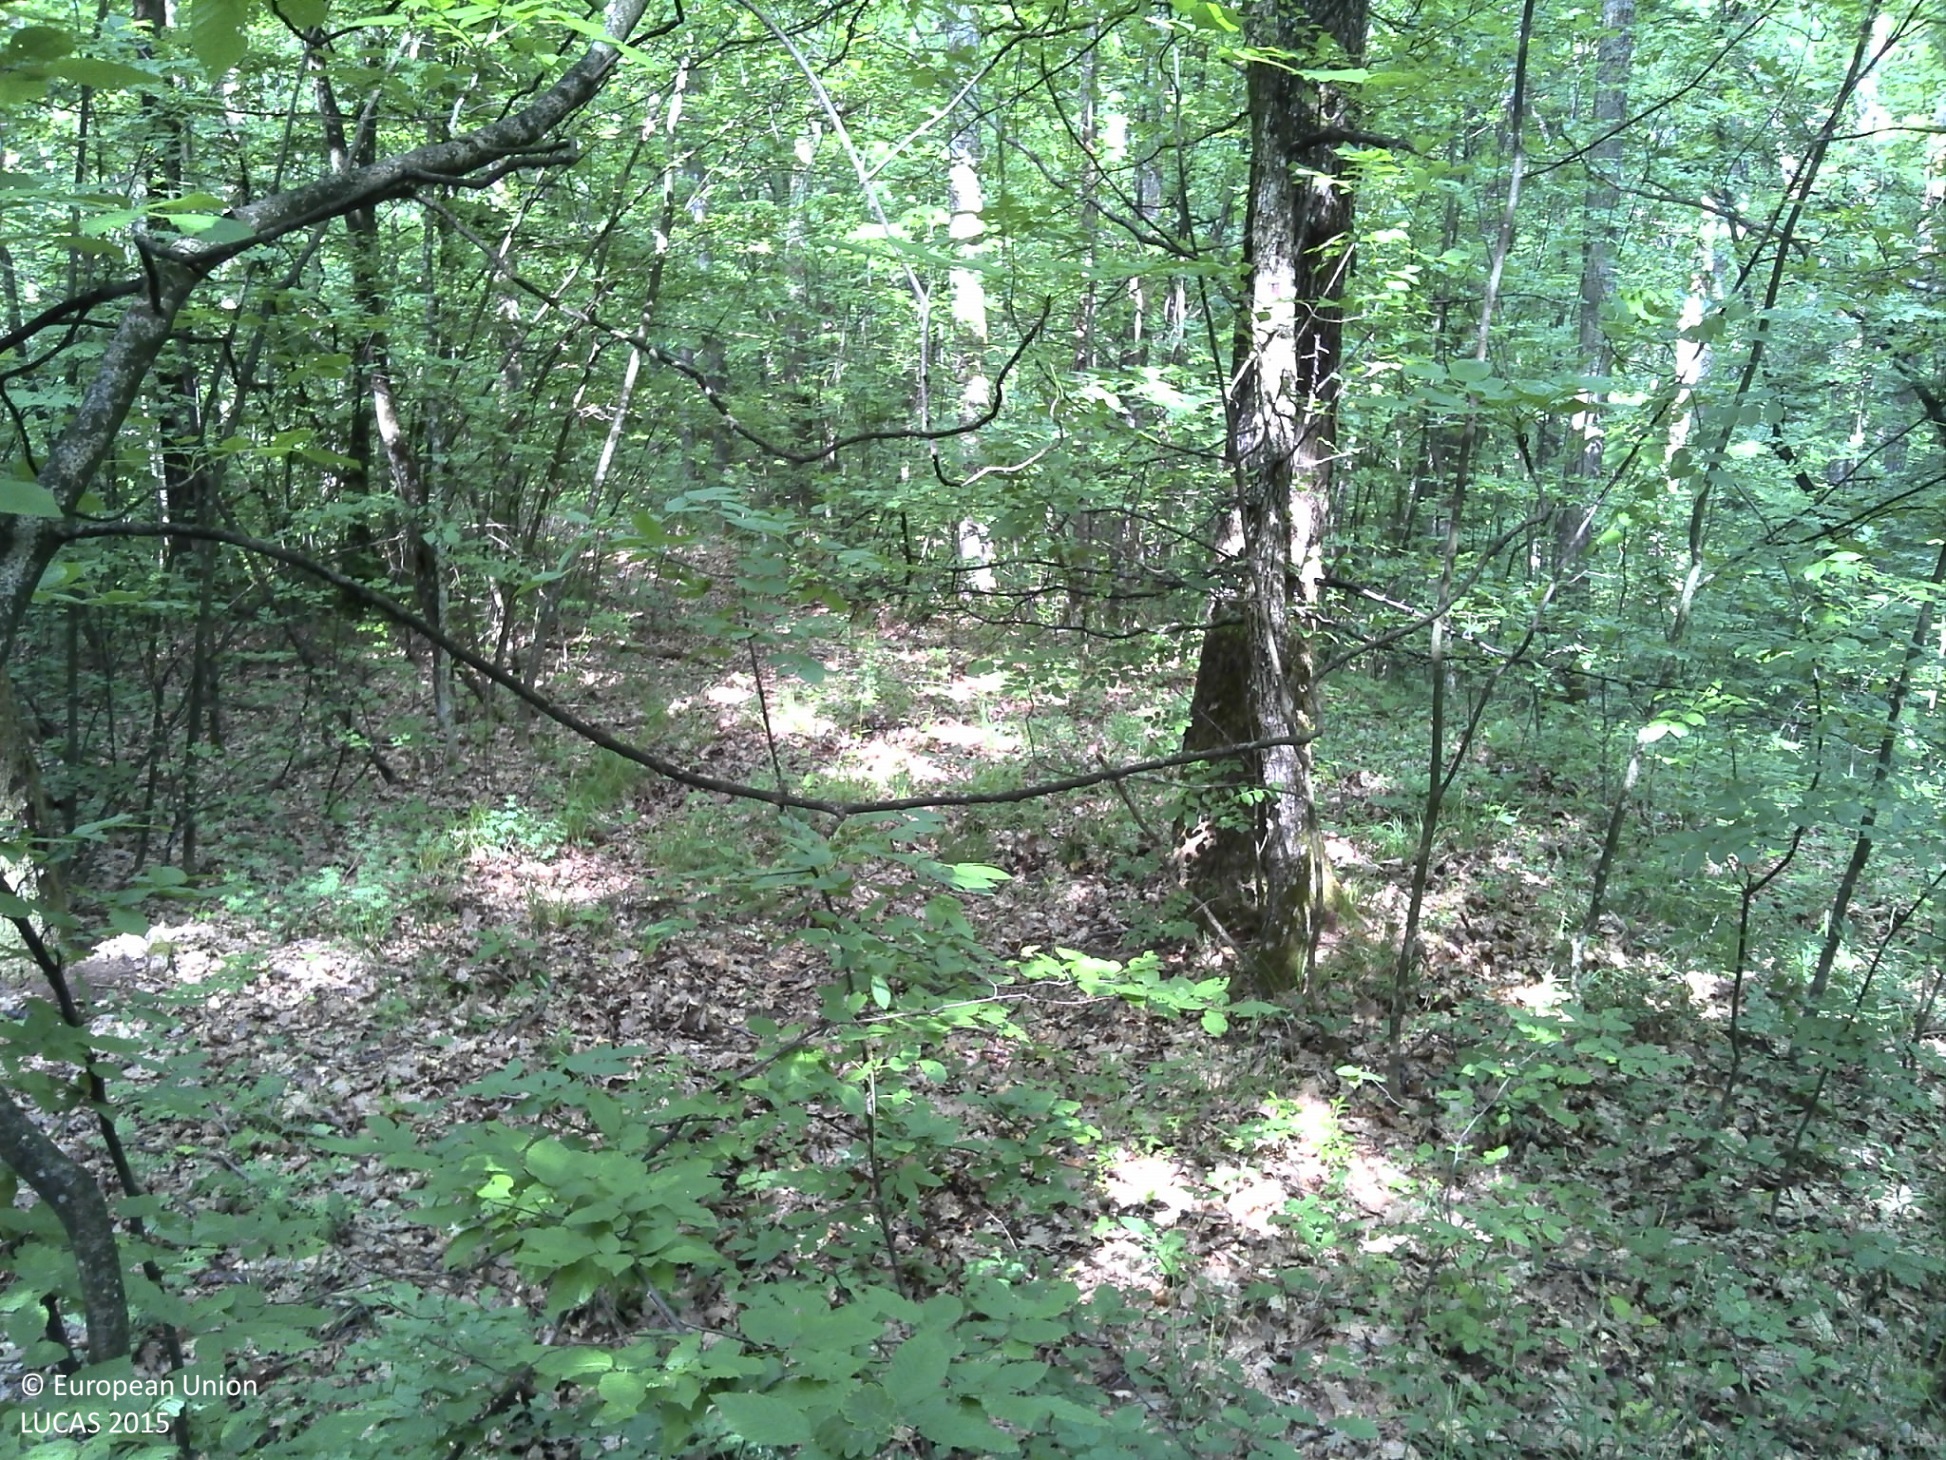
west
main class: Woodland
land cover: Broadleaved woodland
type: mesophytic deciduous forest
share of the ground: > 75 %
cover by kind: broadleaved forest trees 100 %
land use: Forestry
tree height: > 5 m
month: May
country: HR
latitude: 45.4068
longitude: 18.1427
